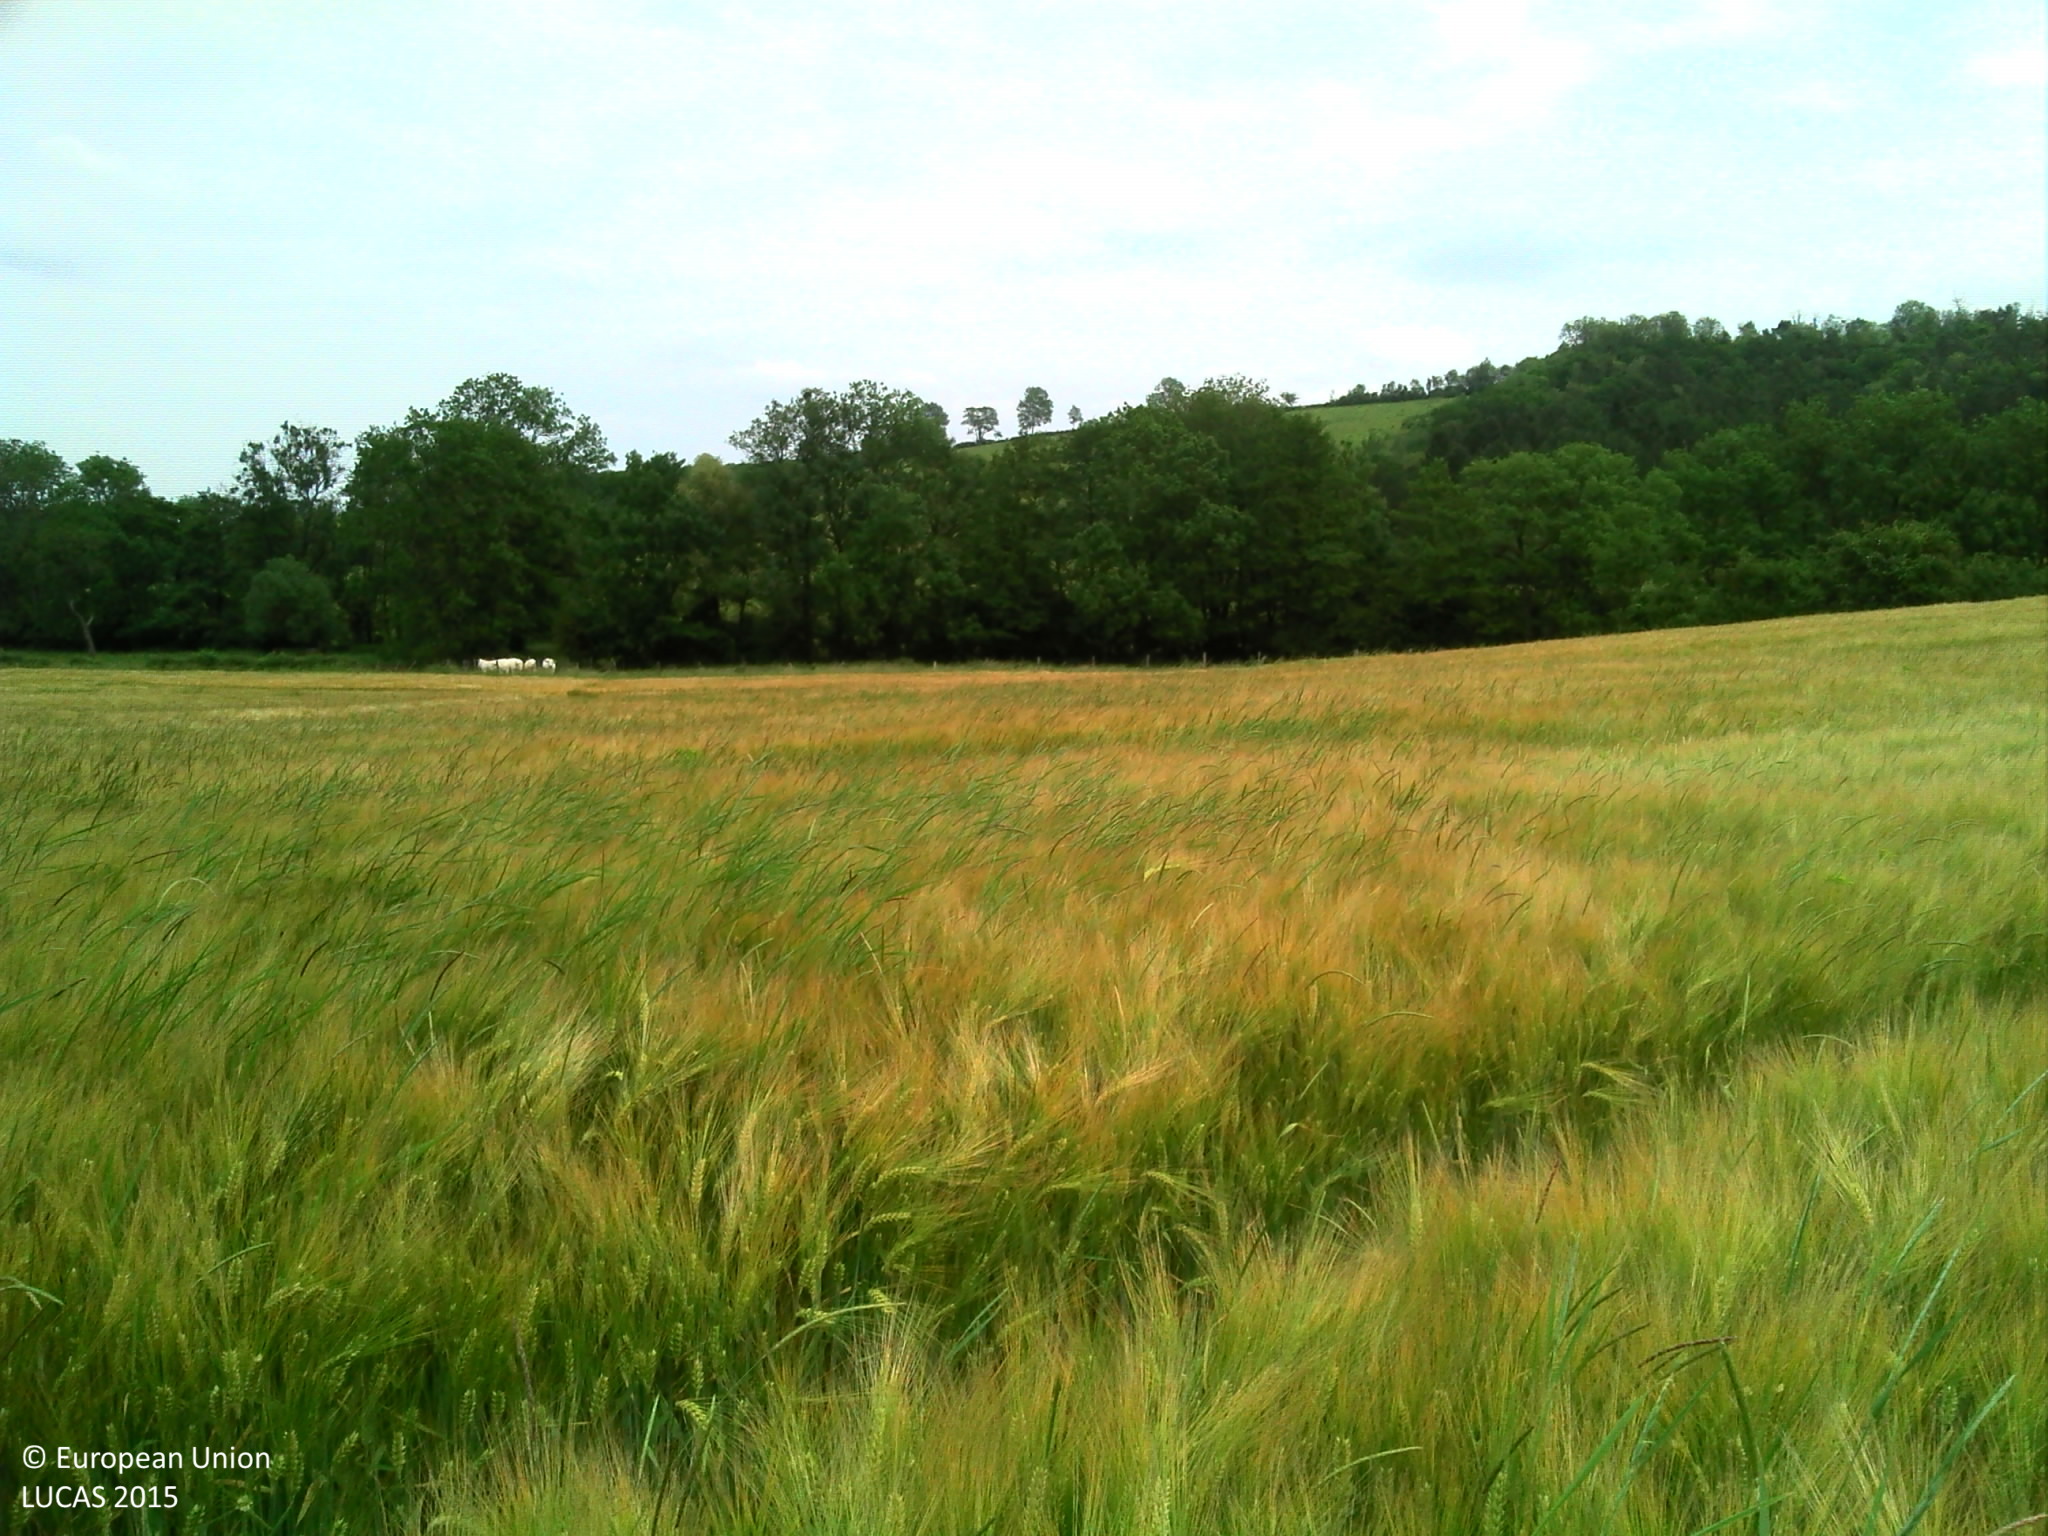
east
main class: Cropland
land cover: Barley
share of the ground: > 75 %
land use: Agriculture (excluding fallow land and kitchen gardens)
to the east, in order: Barley; Grass margins; Ditches and canals; Grass margins; Paved roads, cycling and walking lanes; Grass margins; Ditches and canals; Grass margins; Fences; Grassland without tree/shrub cover; Fences; Broadleaved woodland; Rivers and streams; Broadleaved woodland; Grassland without tree/shrub cover; Ditches and canals; Grassland with sparse tree/shrub cover
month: June
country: FR
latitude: 48.5200
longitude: 6.2499
